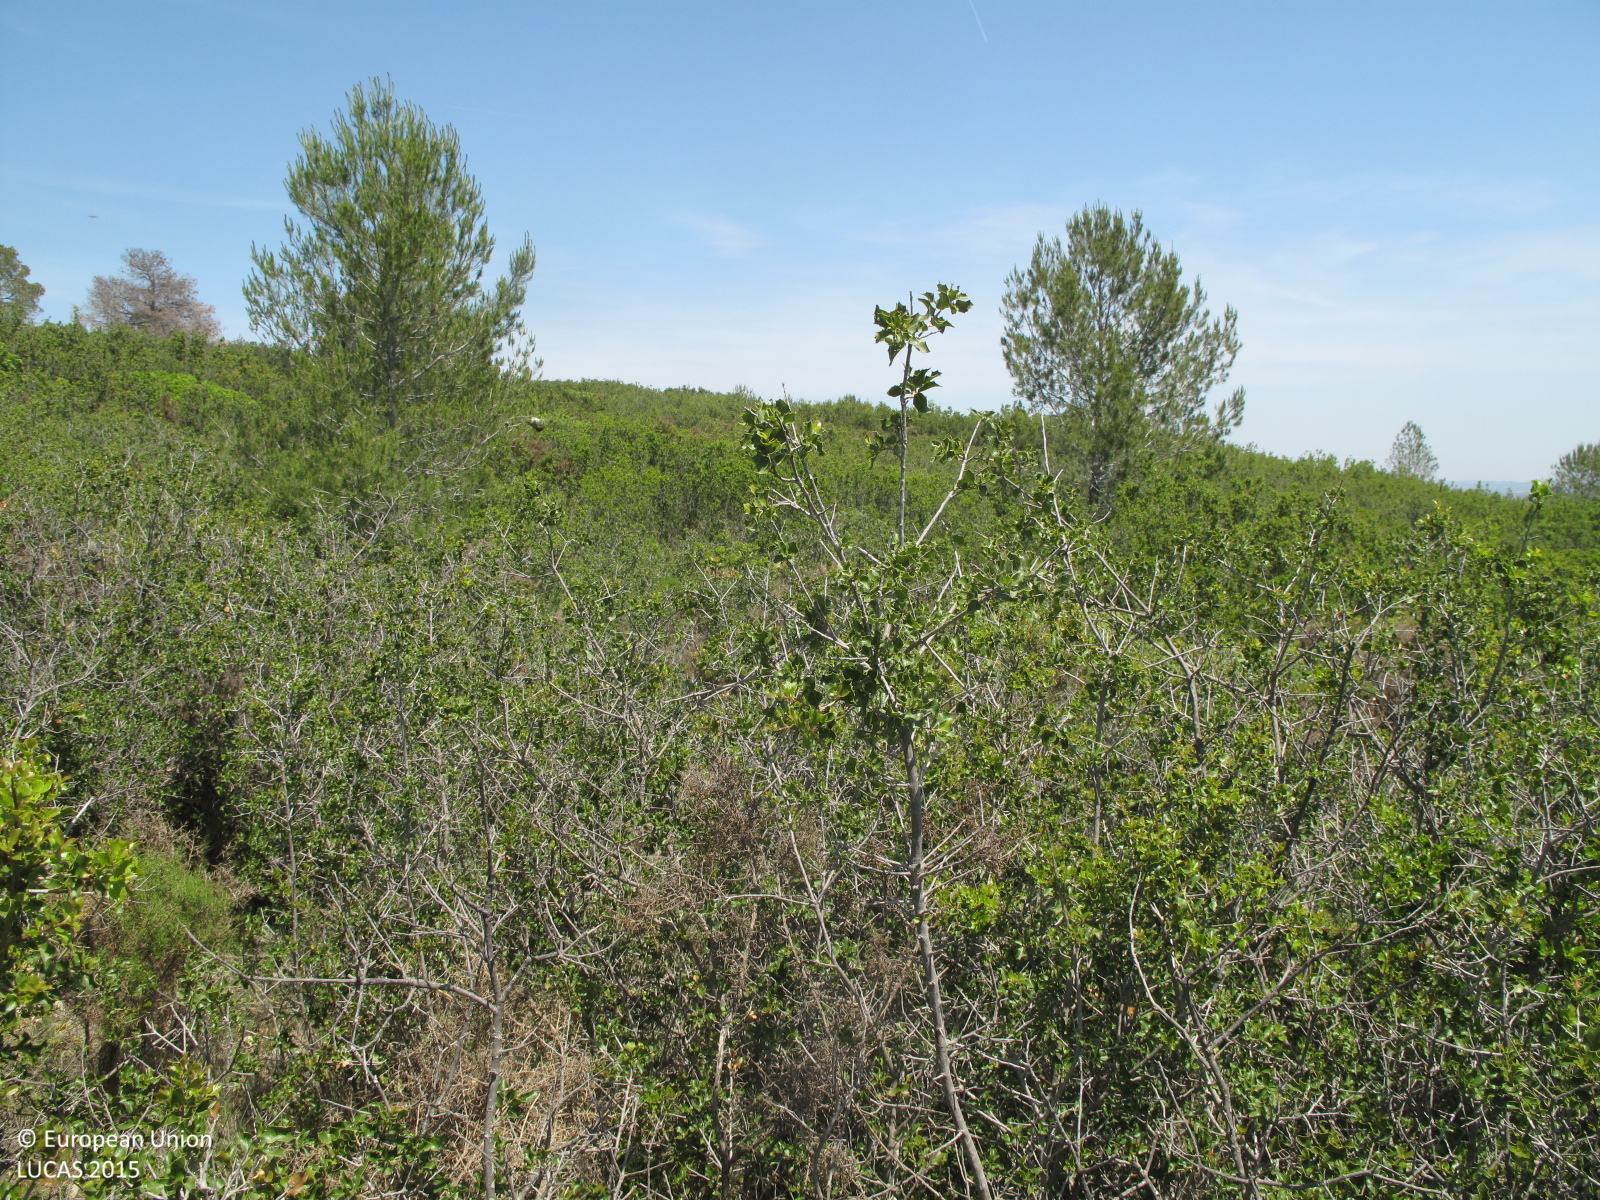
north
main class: Shrubland
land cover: Shrubland with sparse tree cover
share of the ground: > 75 %
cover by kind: shrubs 80 %, consolidated bare surface 15 %, broadleaved forest trees 5 %
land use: Semi-natural and natural areas not in use
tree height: < 5 m
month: May
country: ES
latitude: 38.9467
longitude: -0.7351
